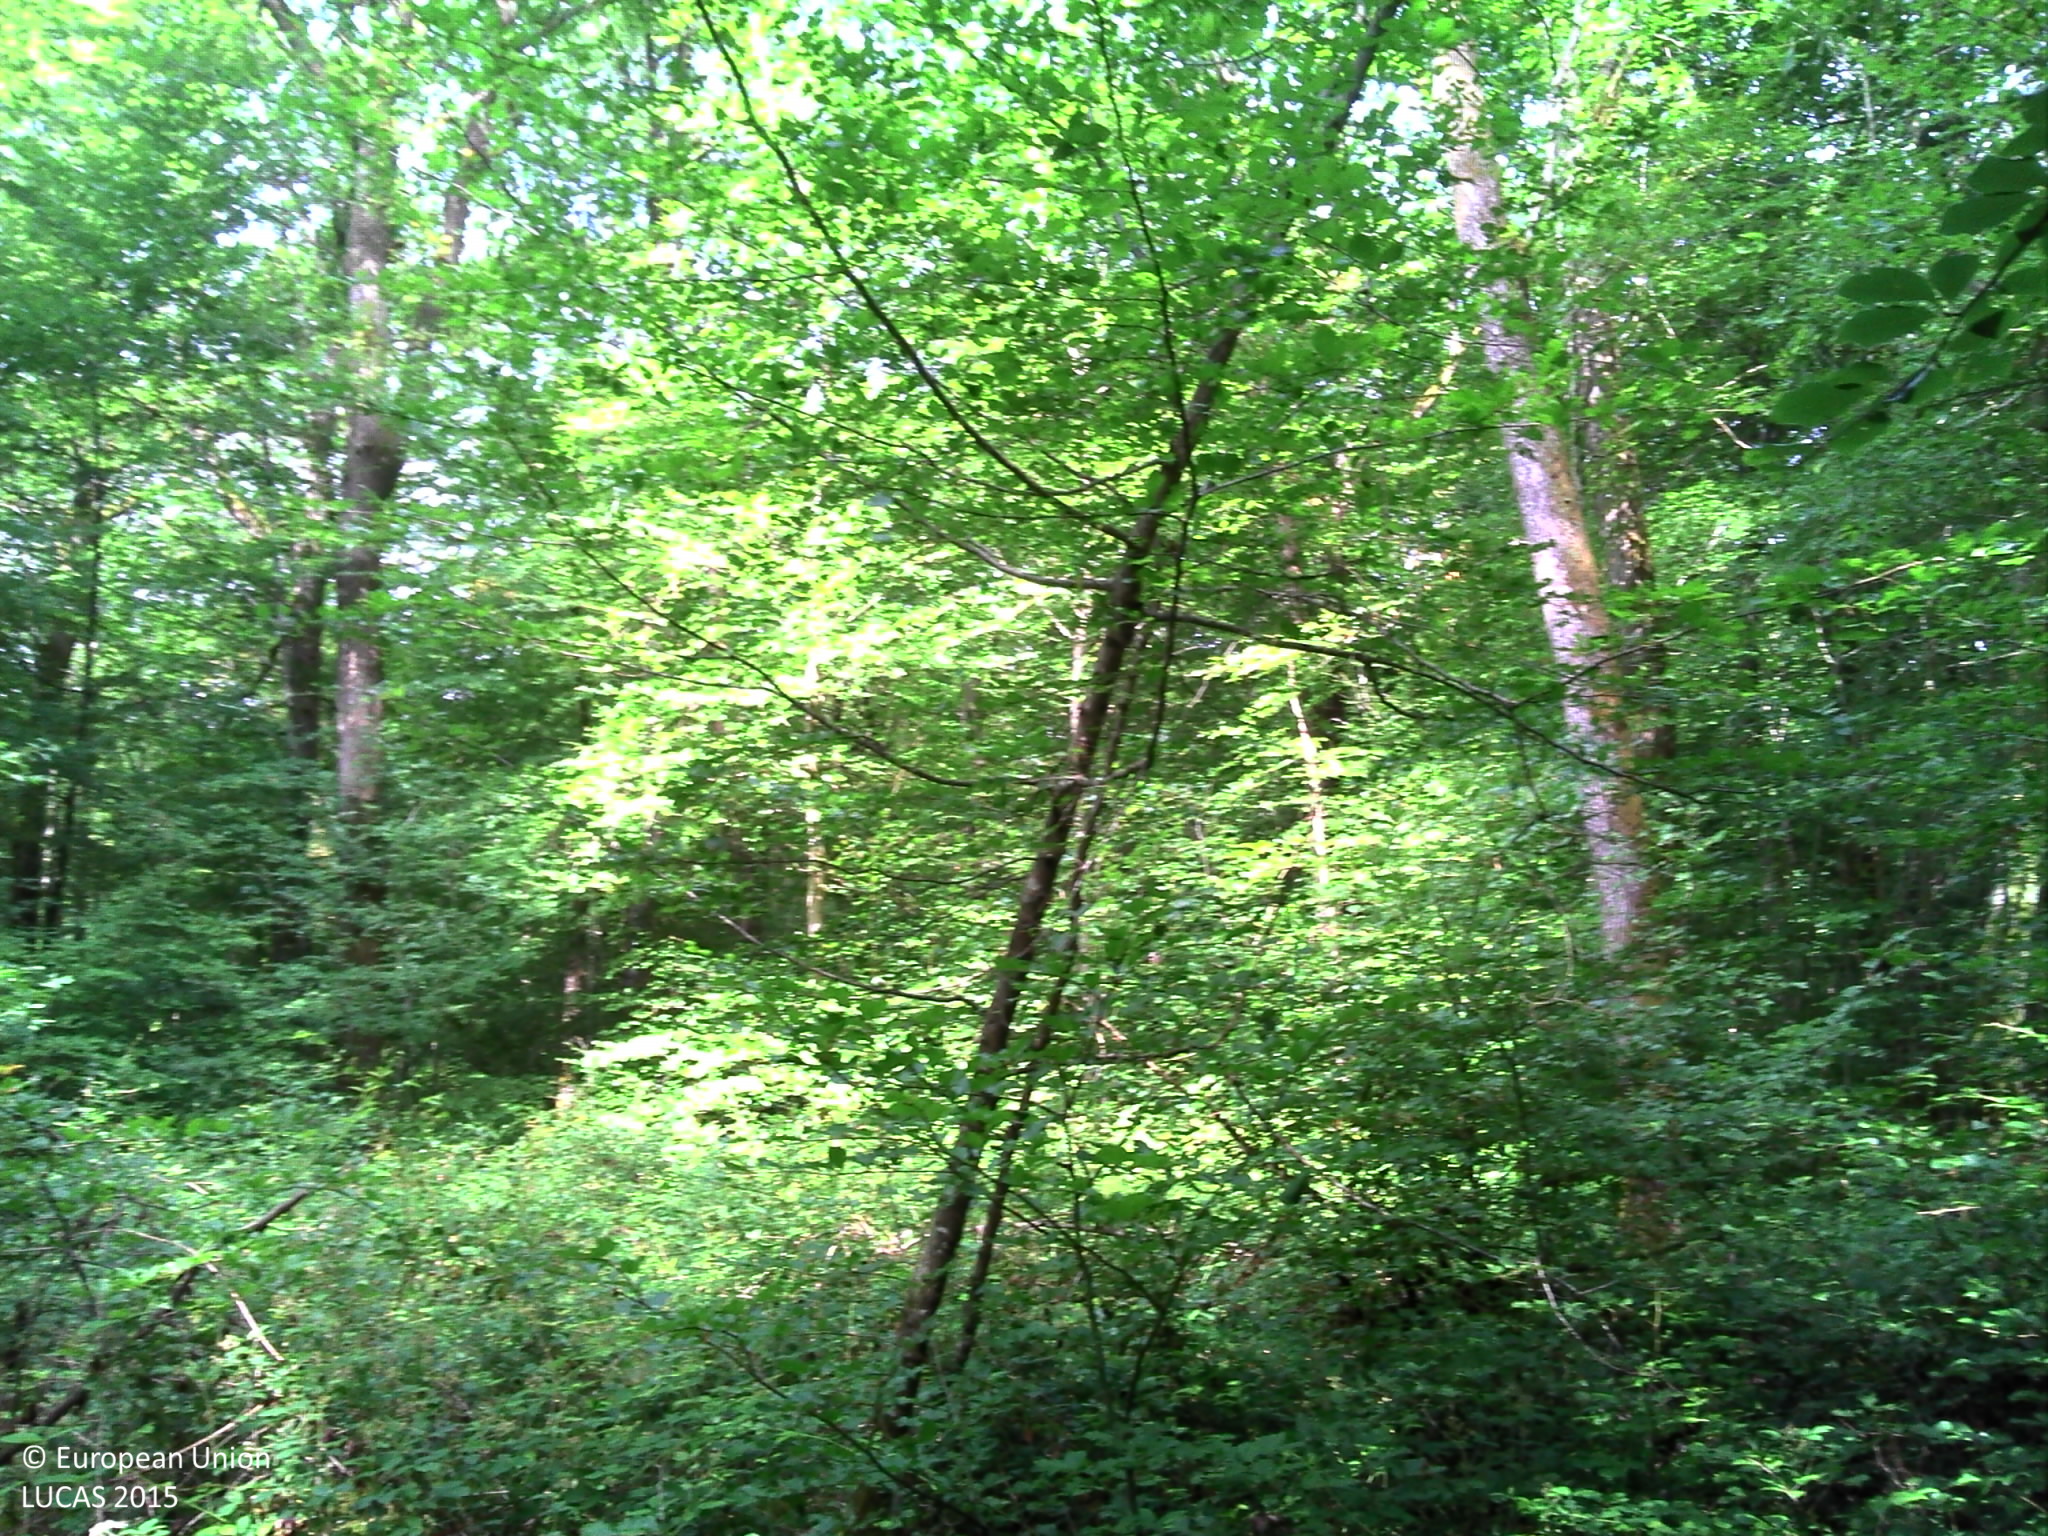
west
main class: Woodland
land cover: Broadleaved woodland
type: mesophytic deciduous forest
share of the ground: > 75 %
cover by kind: broadleaved forest trees 85 %, shrubs 10 %, herbaceous plants 5 %
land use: Forestry
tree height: > 5 m
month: June
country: FR
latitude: 47.1256
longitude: 3.1544
